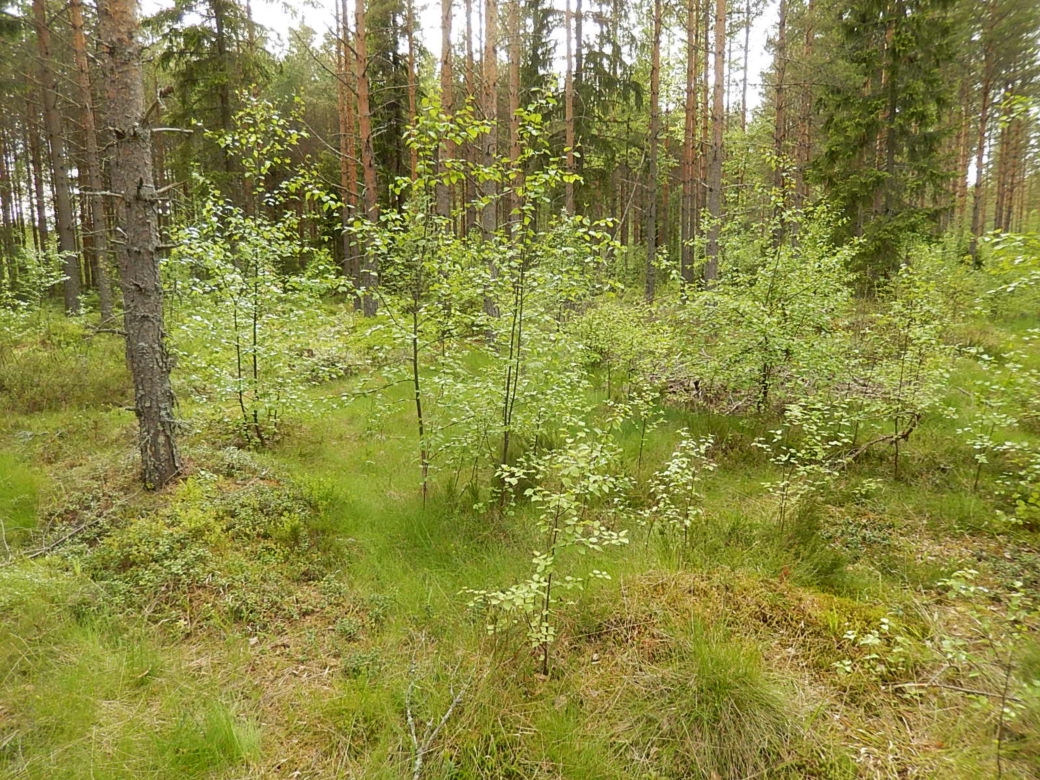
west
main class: Woodland
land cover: Pine dominated coniferous woodland
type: boreal forest
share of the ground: > 75 %
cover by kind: coniferous forest trees 70 %, broadleaved forest trees 10 %, shrubs 10 %, herbaceous plants 10 %
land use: Forestry
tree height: > 5 m
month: June
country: FI
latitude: 61.8860
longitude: 21.6342
